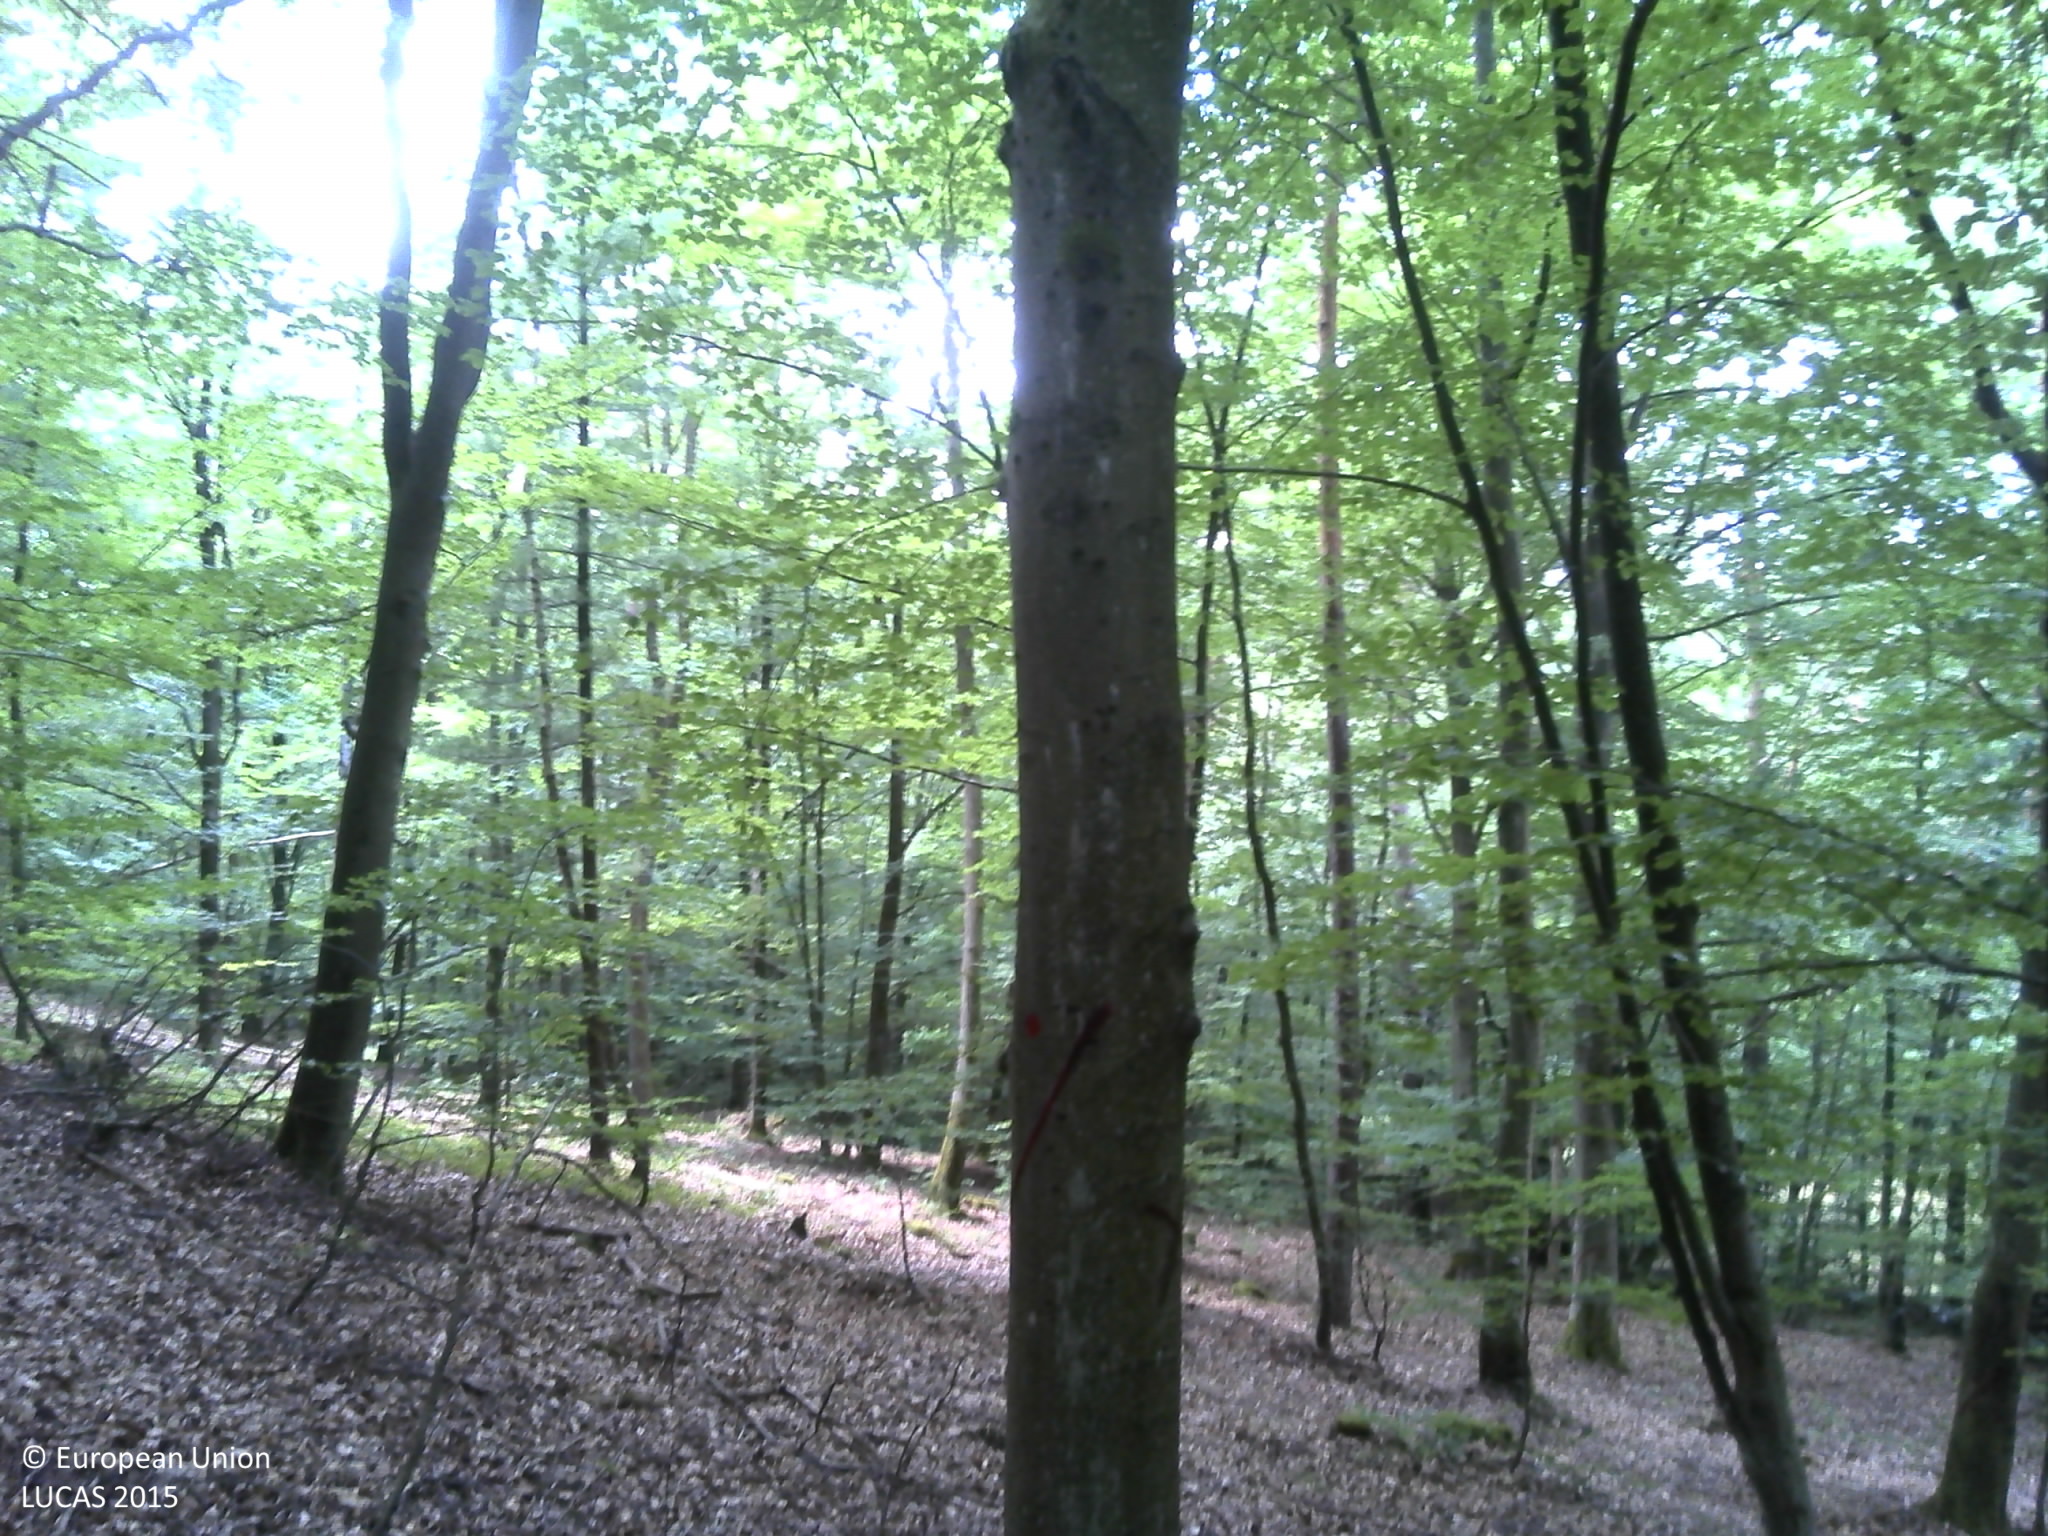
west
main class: Woodland
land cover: Broadleaved woodland
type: beech forest
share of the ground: > 75 %
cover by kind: broadleaved forest trees 95 %, coniferous forest trees 5 %
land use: Forestry
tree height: > 5 m
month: July
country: FR
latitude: 49.0957
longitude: 7.5217
